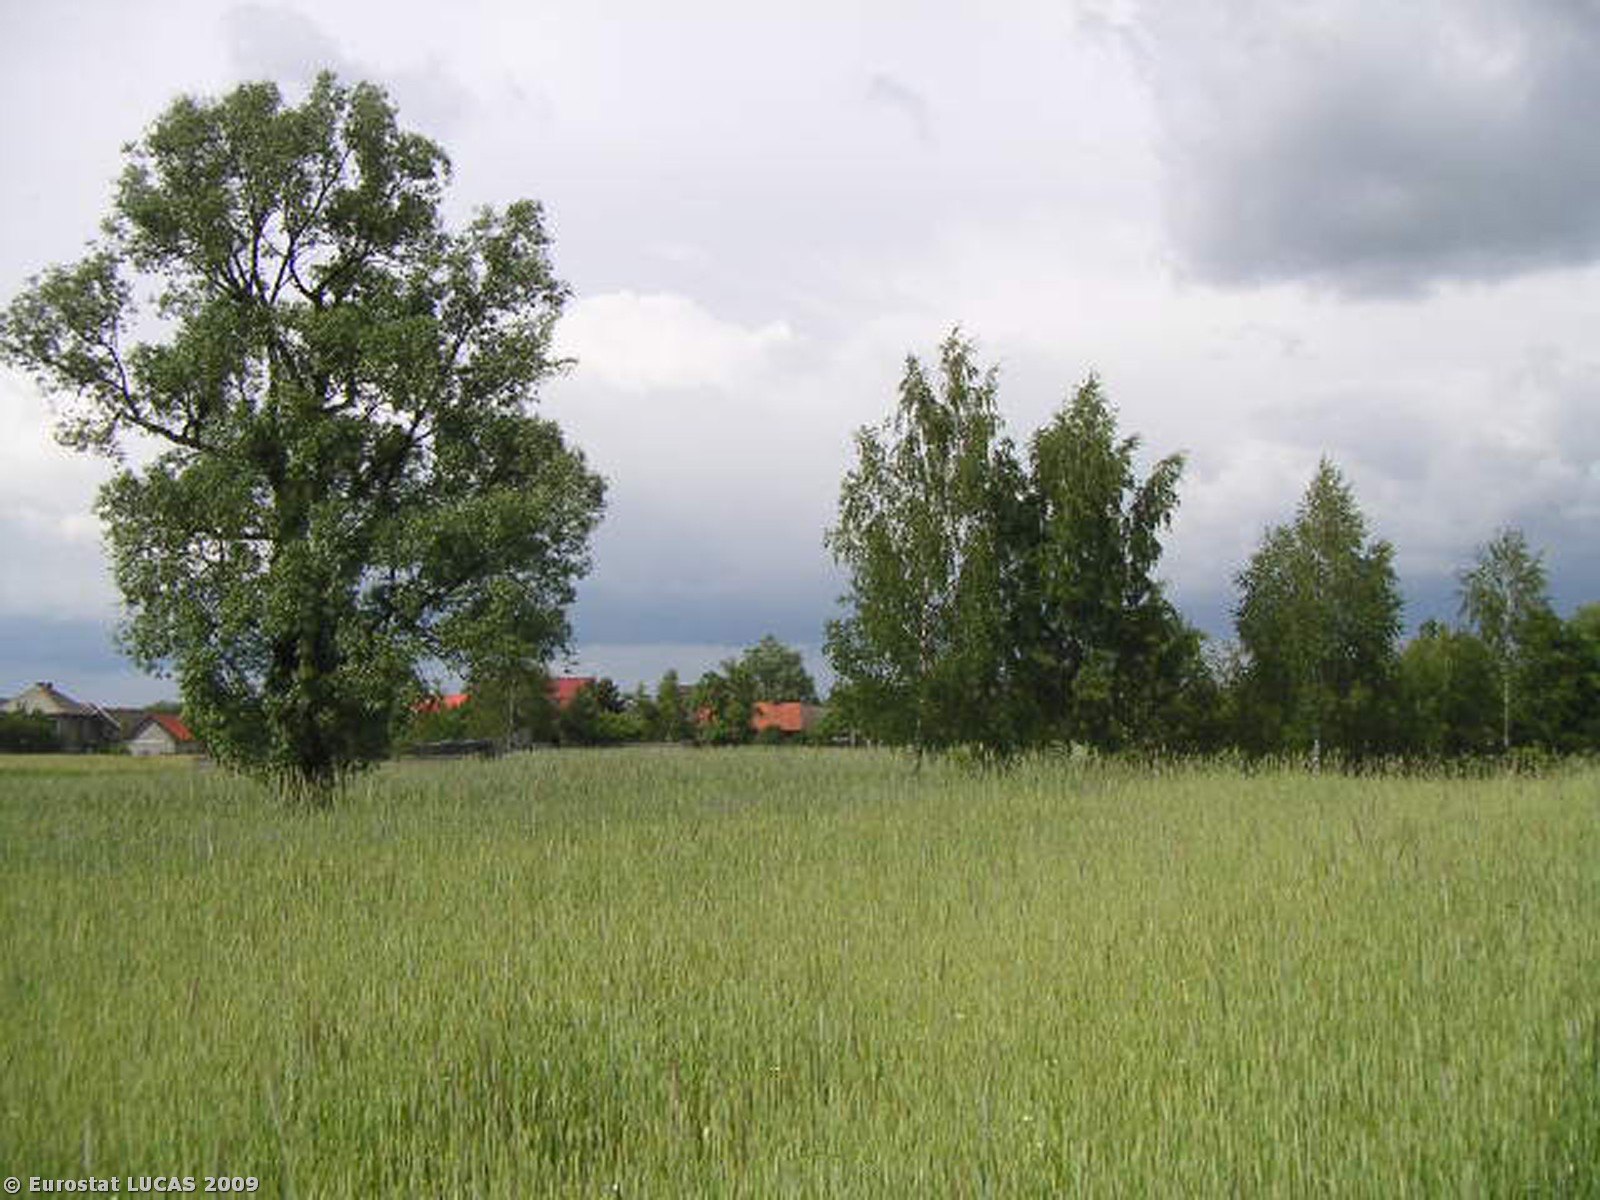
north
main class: Cropland
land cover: Barley
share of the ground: 50 - 75 %
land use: Agriculture (excluding fallow land and kitchen gardens)
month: May
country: PL
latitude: 49.9923
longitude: 19.6393
